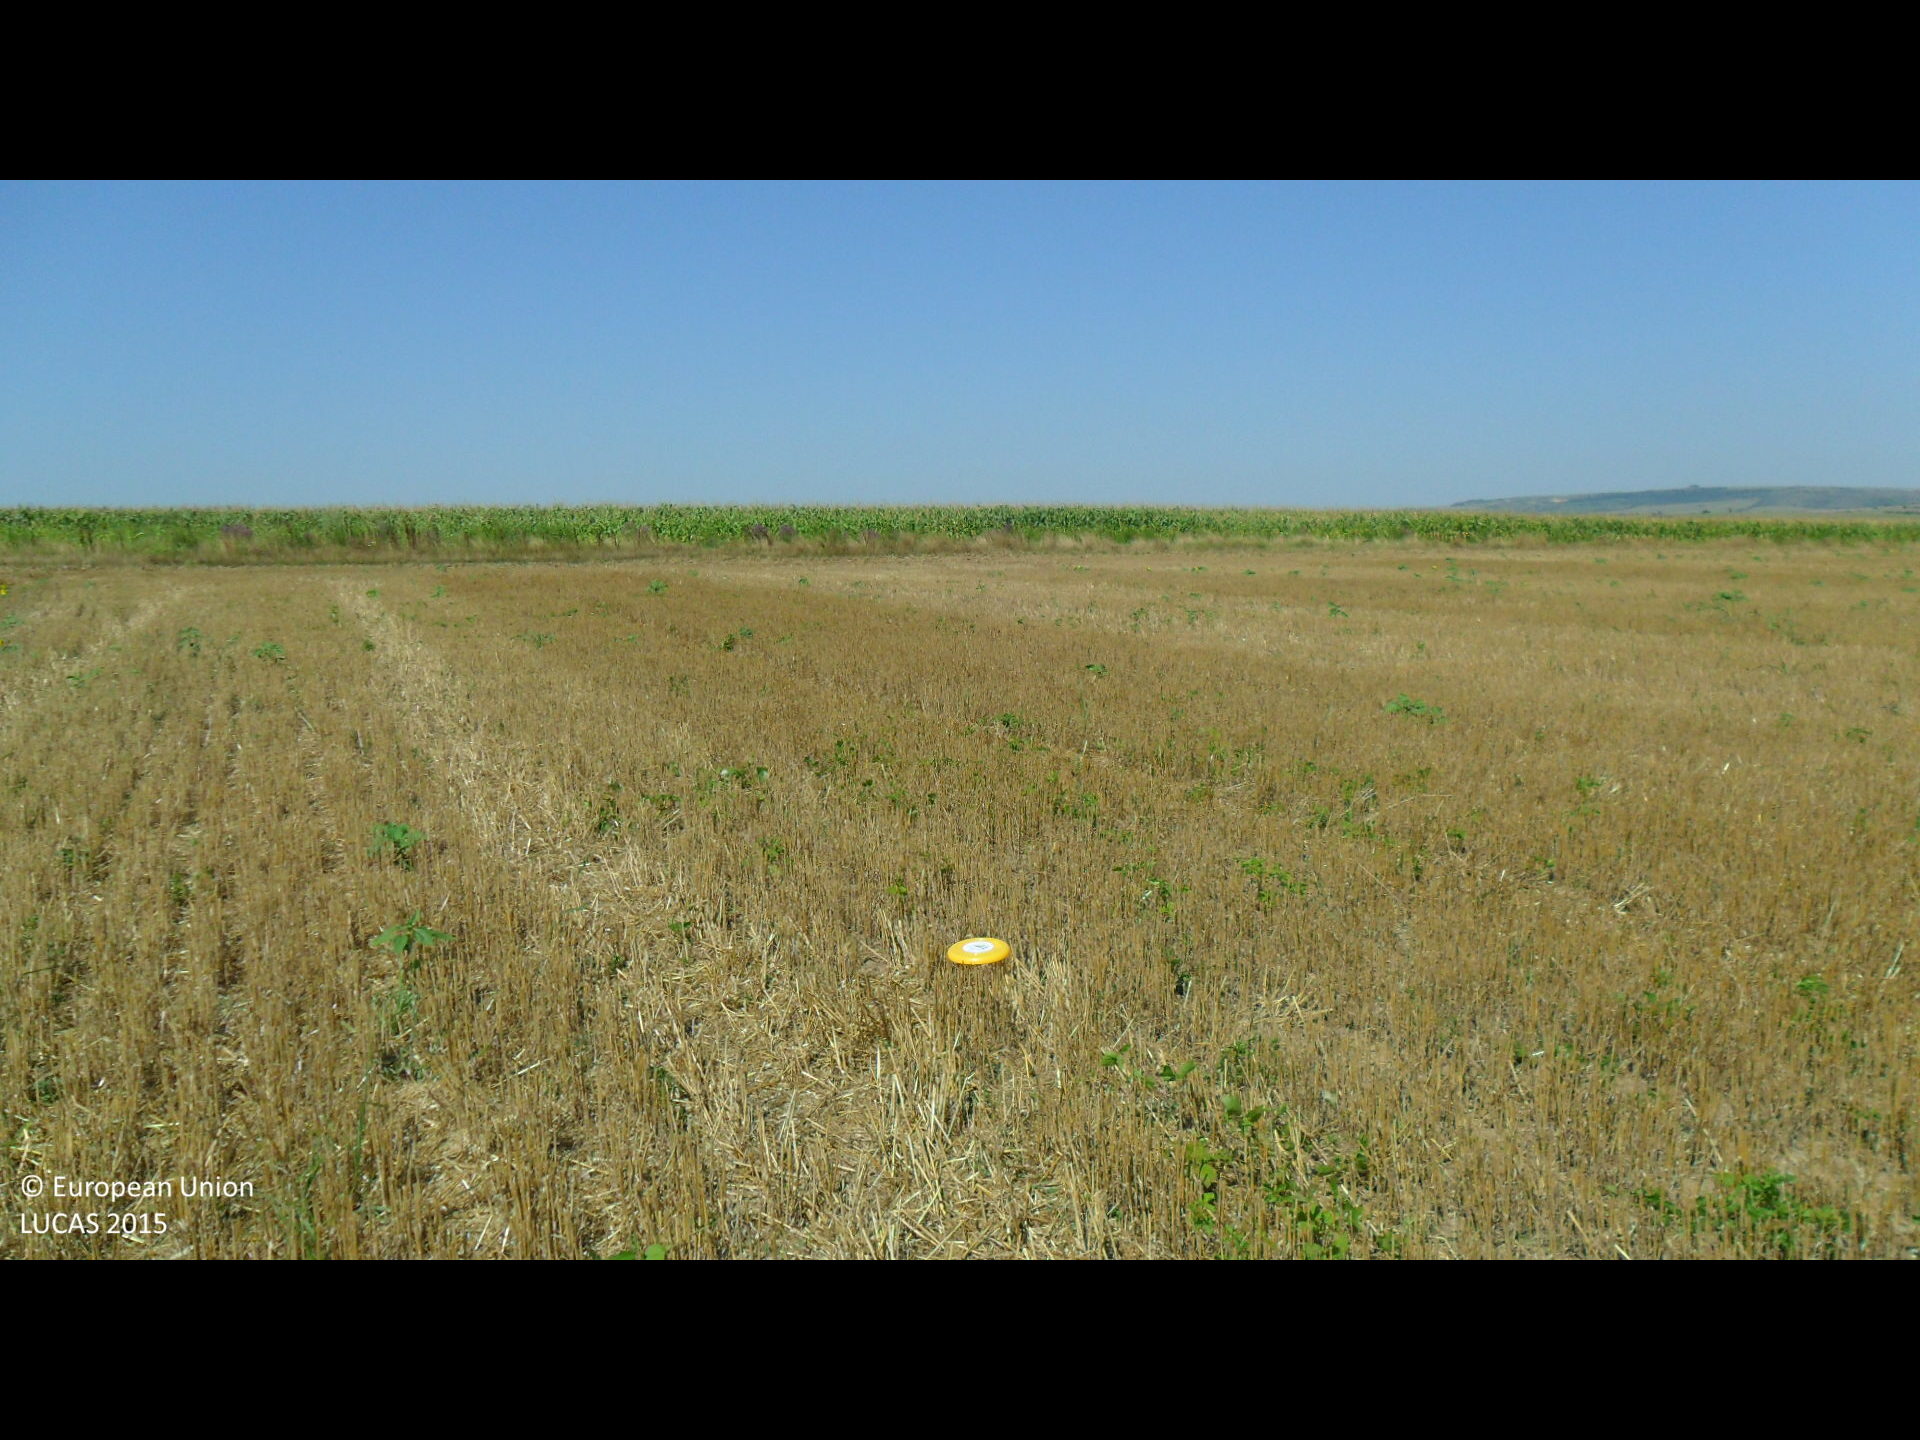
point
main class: Cropland
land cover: Barley
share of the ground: < 10 %
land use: Agriculture (excluding fallow land and kitchen gardens)
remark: Harvested field
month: August
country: BG
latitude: 43.3439
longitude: 26.1936
